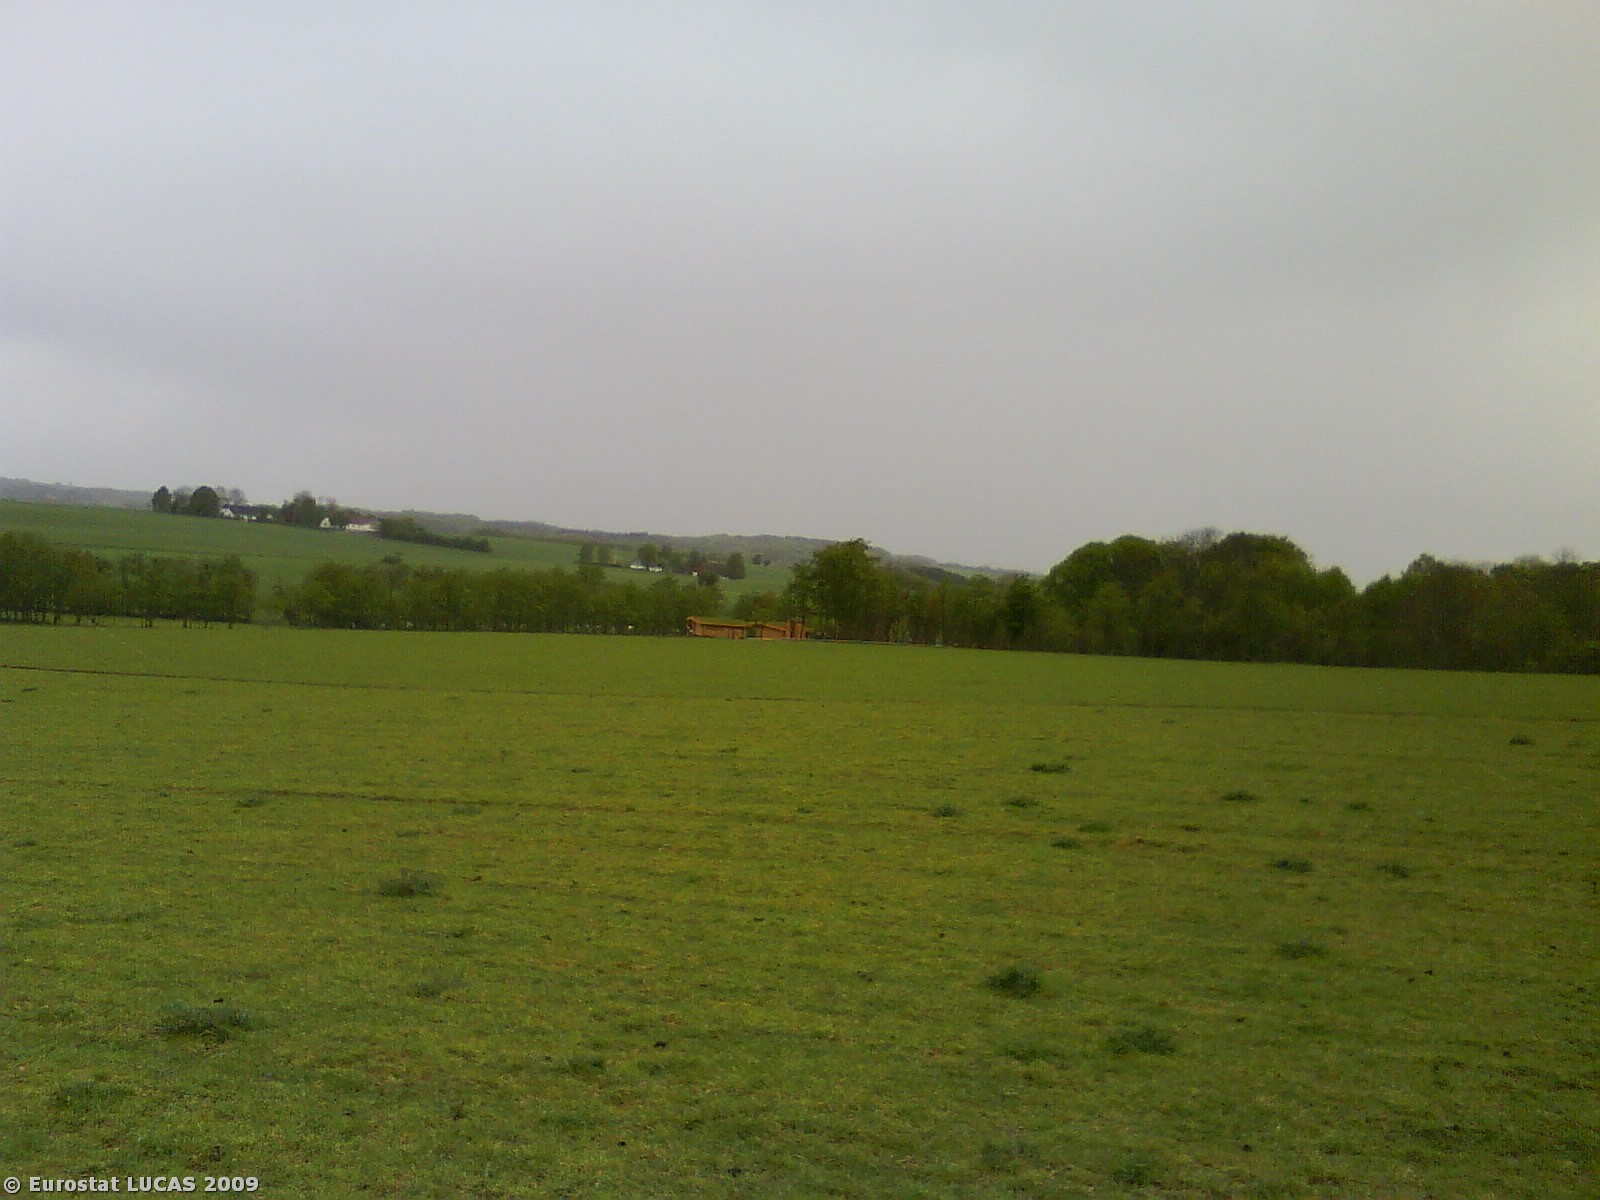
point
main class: Grassland
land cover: Grassland without tree/shrub cover
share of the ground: > 75 %
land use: Agriculture (excluding fallow land and kitchen gardens)
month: May
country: DK
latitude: 56.4034
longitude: 10.1133
